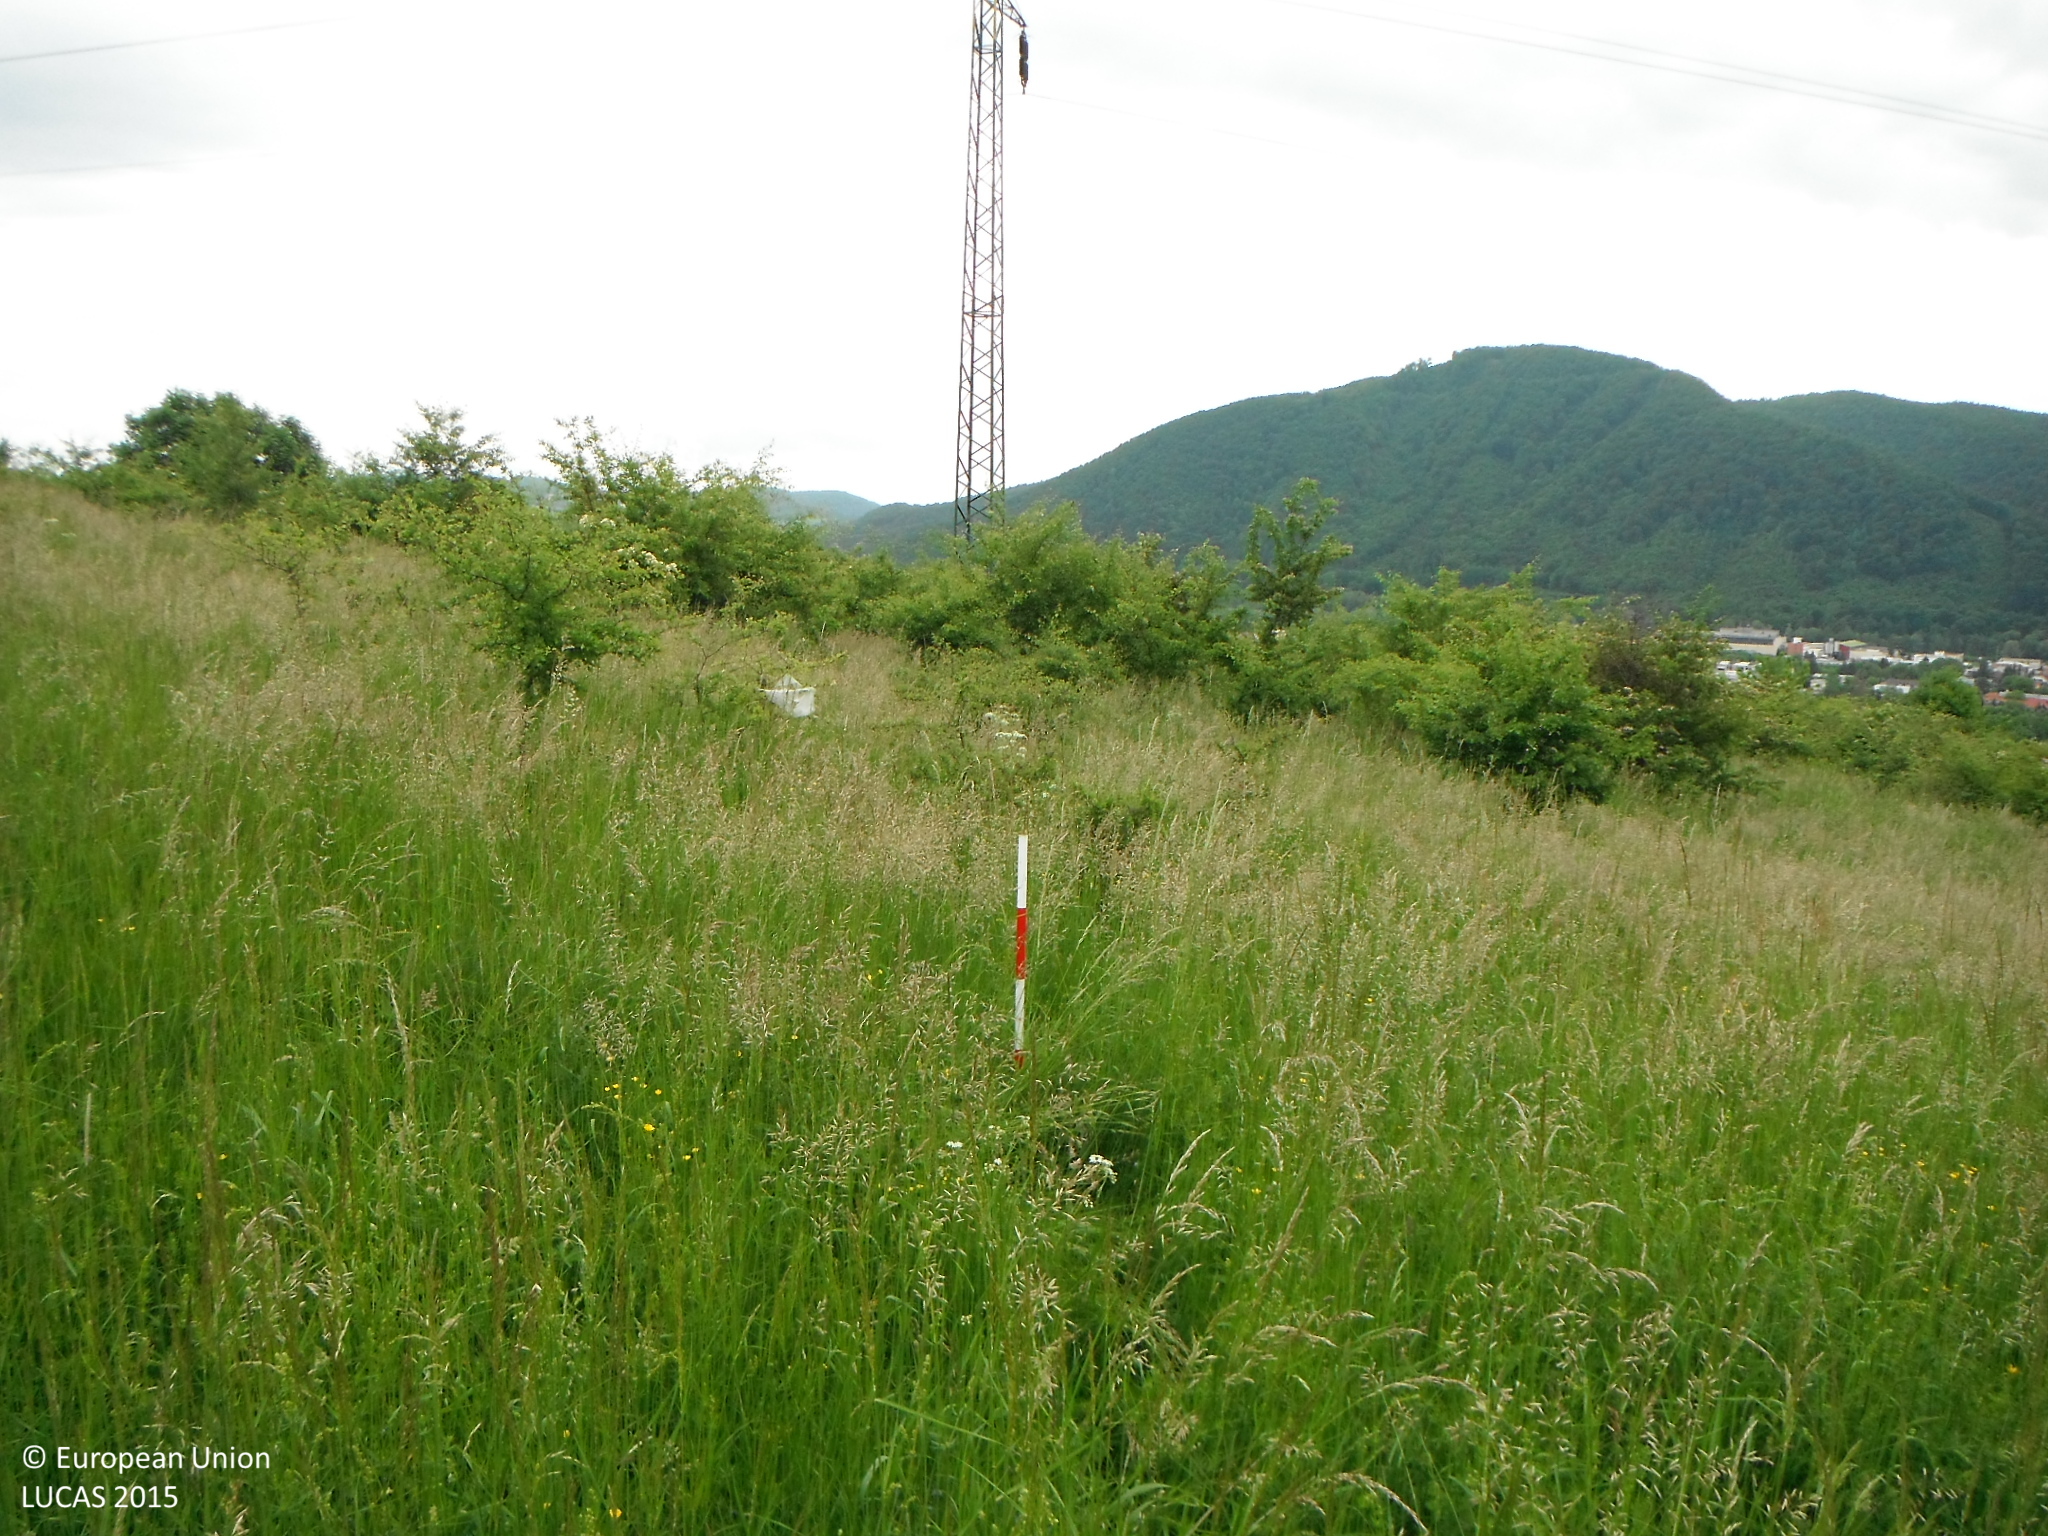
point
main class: Grassland
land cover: Grassland with sparse tree/shrub cover
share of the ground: > 75 %
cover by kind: herbaceous plants 85 %, shrubs 10 %, broadleaved forest trees 5 %
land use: Agriculture (excluding fallow land and kitchen gardens)
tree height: < 5 m
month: May
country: SK
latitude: 48.7456
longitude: 19.1751
